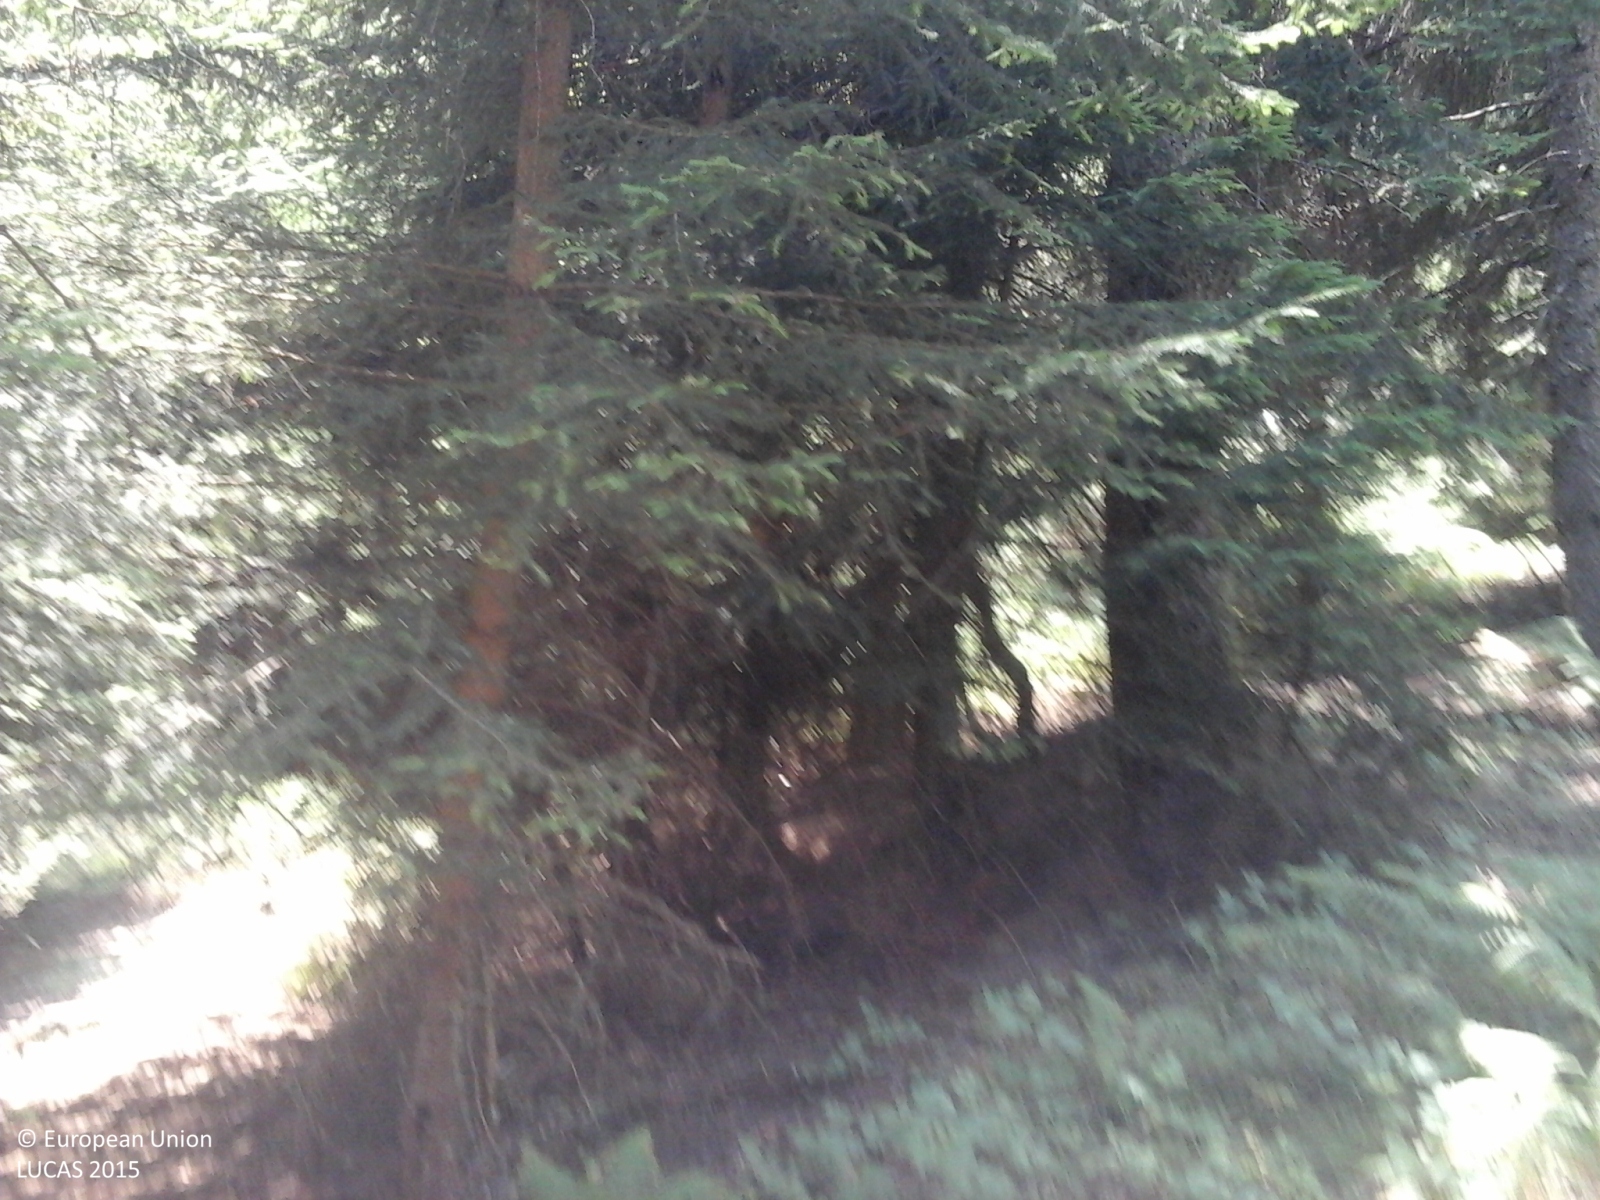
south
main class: Woodland
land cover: Spruce dominated coniferous woodland
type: alpine coniferous forest
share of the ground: > 75 %
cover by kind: coniferous forest trees 100 %
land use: Agriculture (excluding fallow land and kitchen gardens)
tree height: > 5 m
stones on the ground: < 10 %
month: July
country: IT
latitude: 46.1891
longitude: 10.0647
